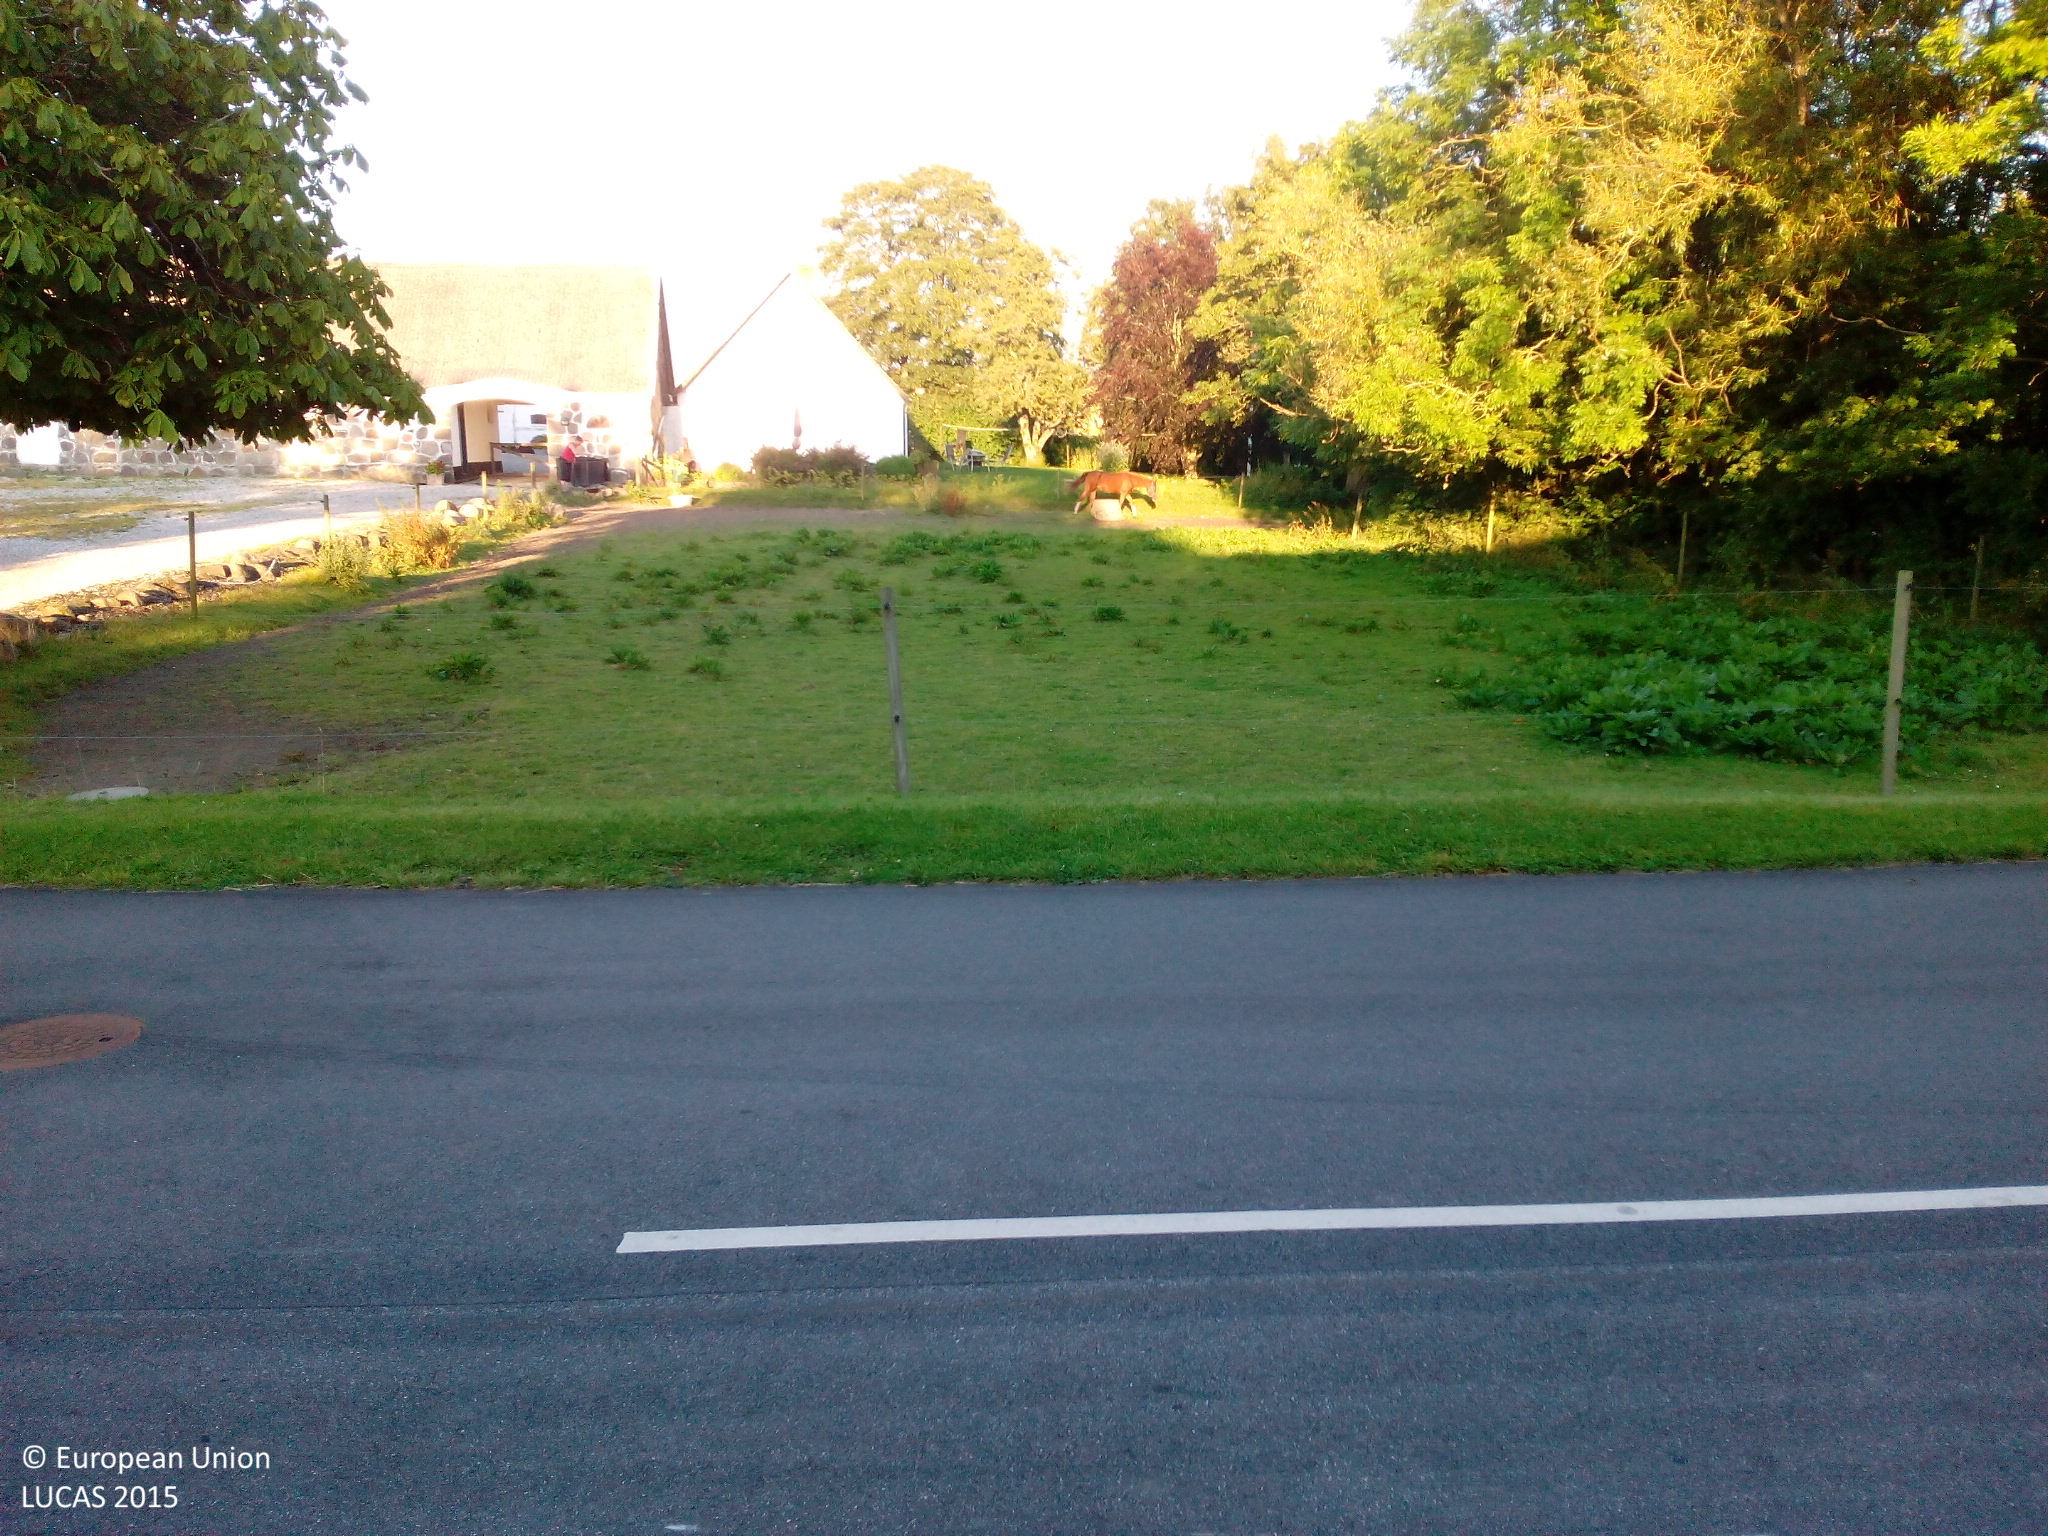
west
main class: Cropland
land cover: Common wheat
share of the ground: > 75 %
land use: Agriculture (excluding fallow land and kitchen gardens)
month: August
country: DK
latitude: 55.5640
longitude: 11.7902
